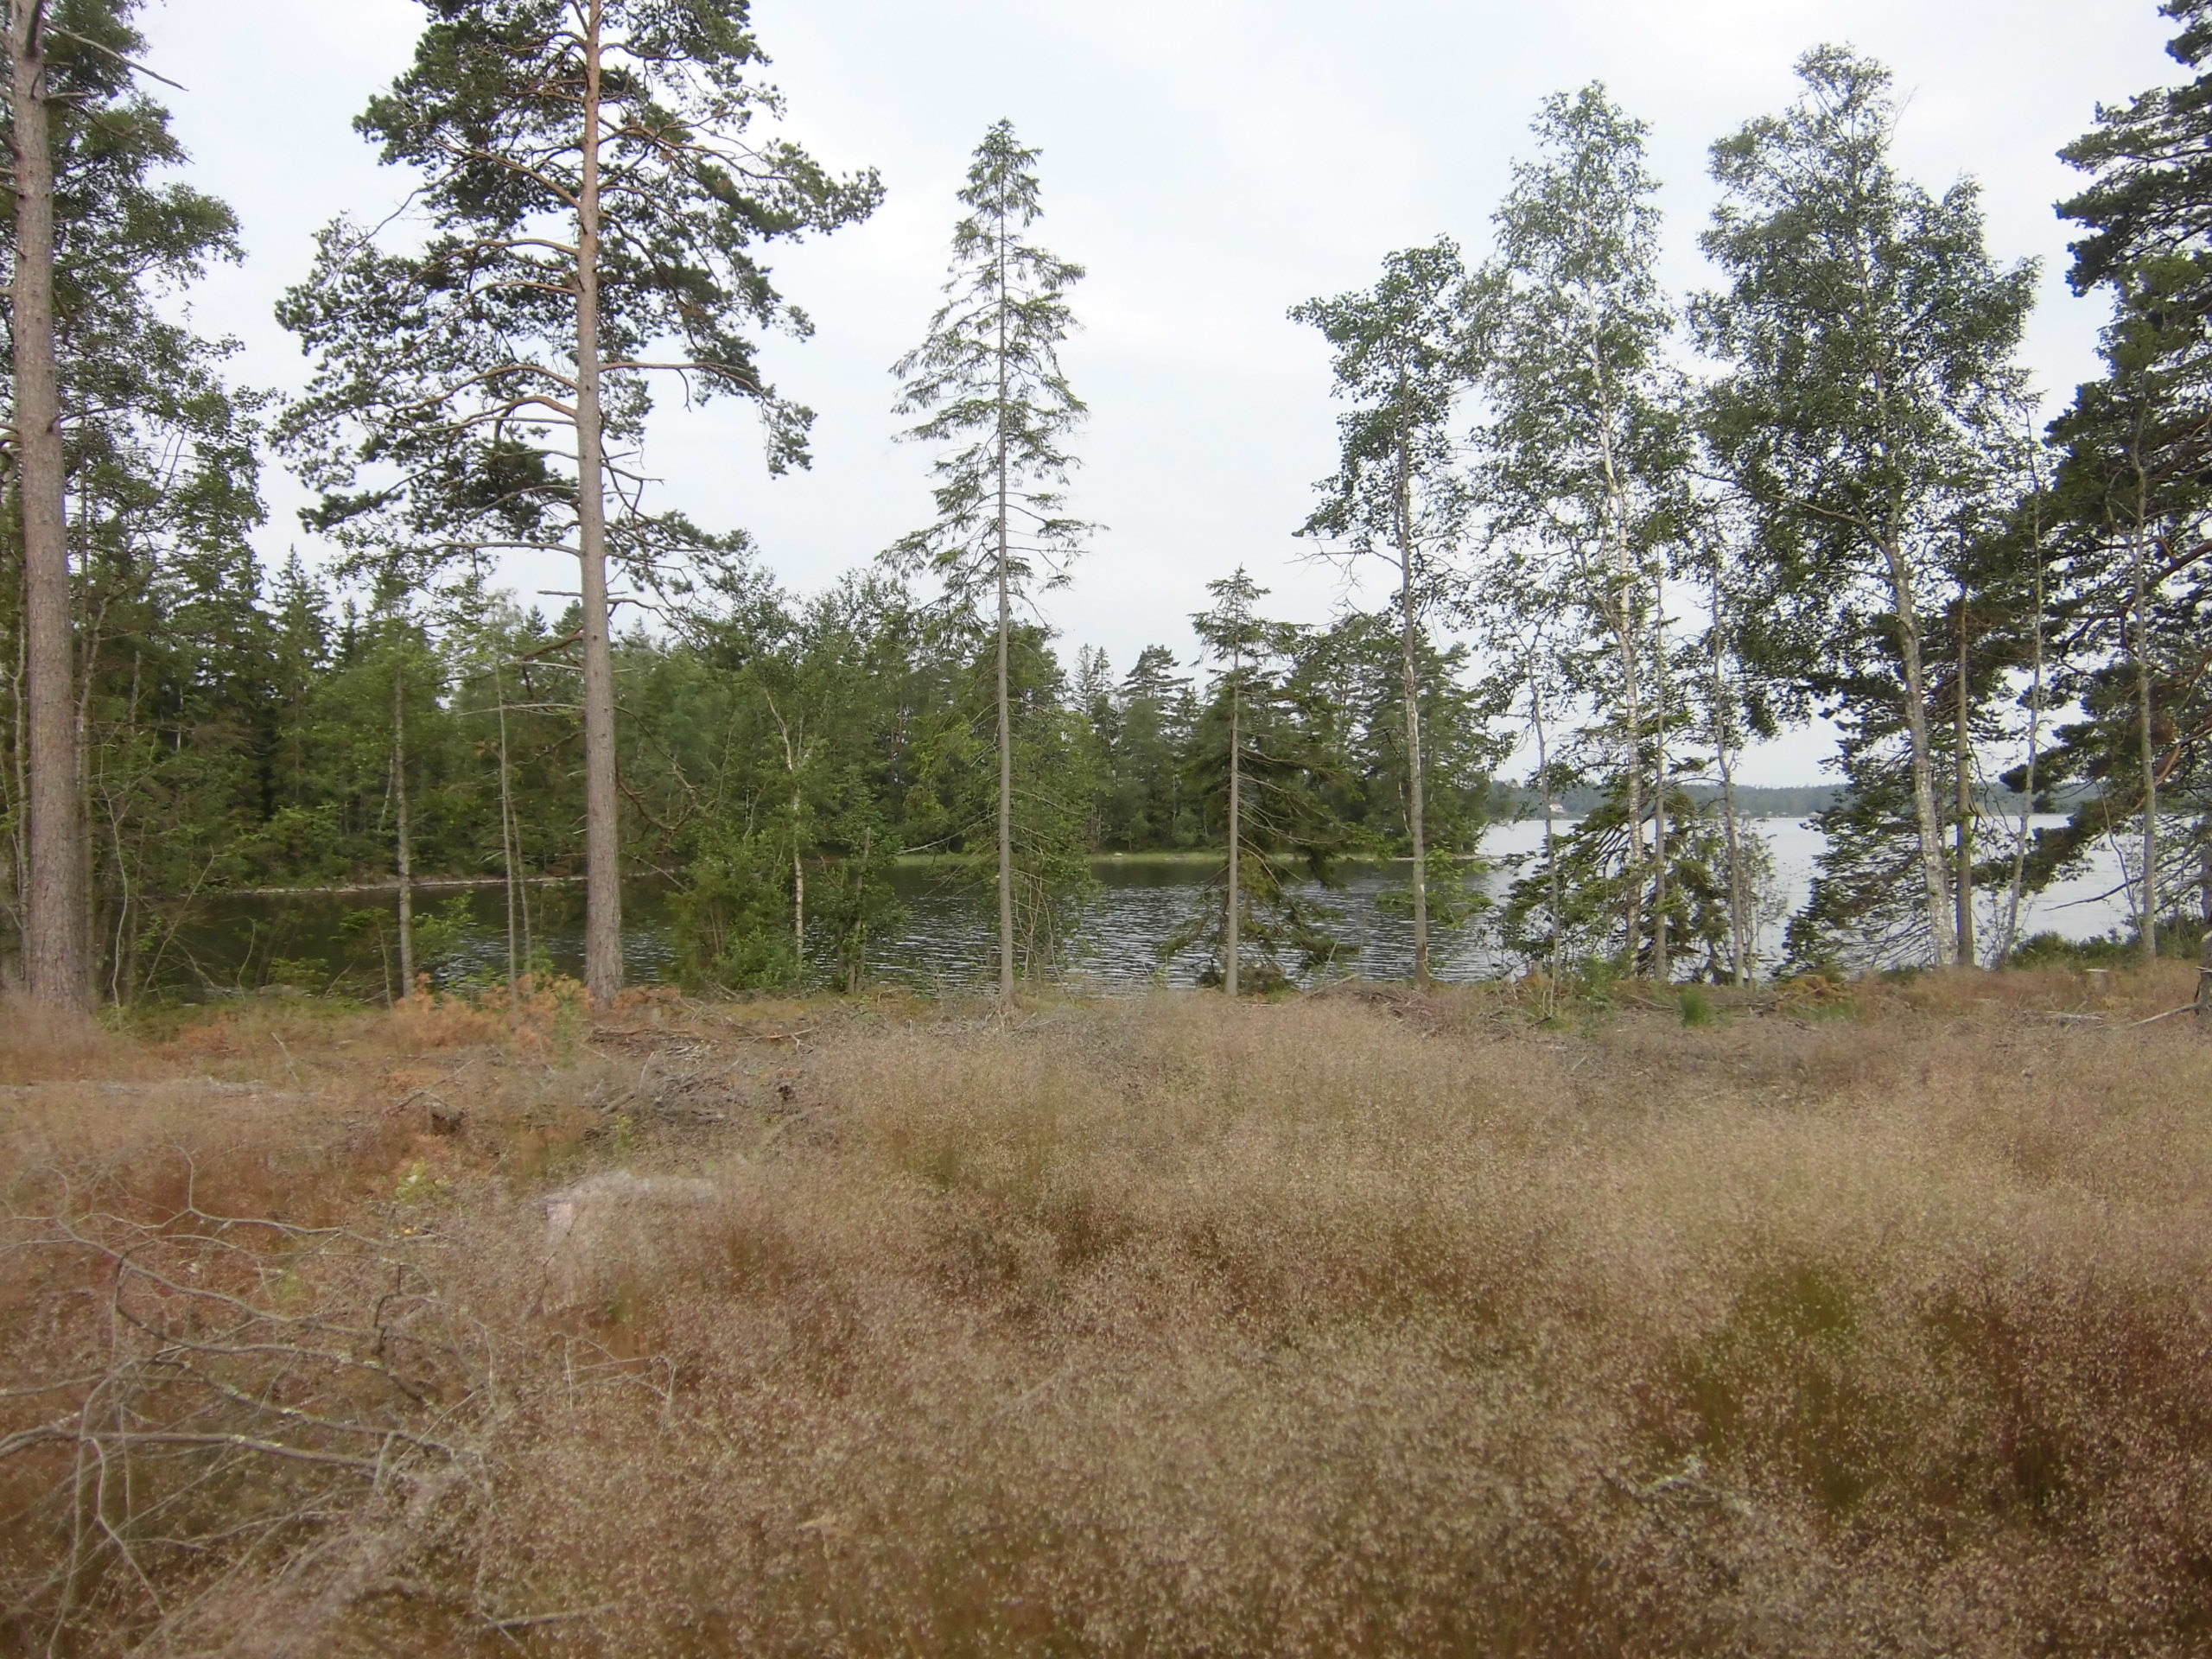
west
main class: Grassland
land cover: Grassland with sparse tree/shrub cover
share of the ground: > 75 %
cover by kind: herbaceous plants 70 %, lichens and mosses 10 %, unconsolidated bare surface 10 %, broadleaved forest trees 5 %, shrubs 5 %
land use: Forestry
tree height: < 5 m
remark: Clear cut
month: July
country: SE
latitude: 57.3961
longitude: 14.7717
